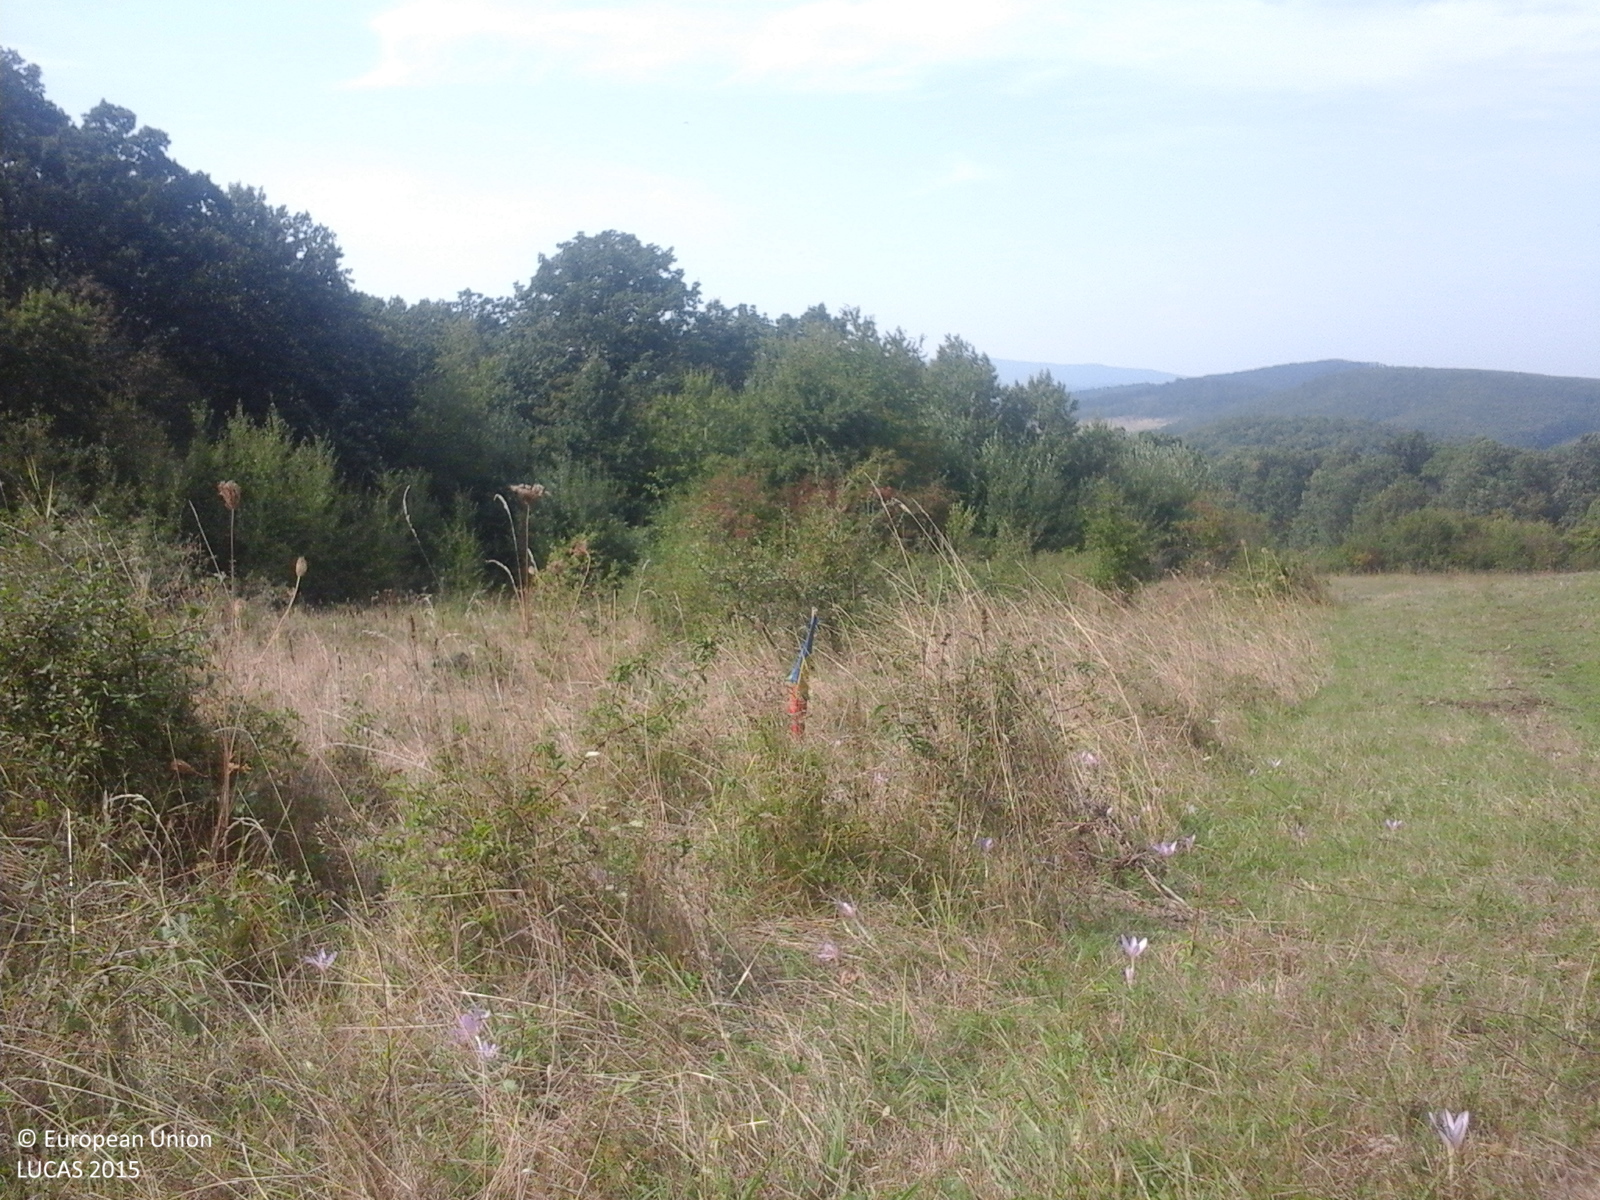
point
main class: Grassland
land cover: Spontaneously vegetated surfaces
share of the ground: > 75 %
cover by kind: herbaceous plants 100 %
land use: Fallow land
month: September
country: RO
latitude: 47.0907
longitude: 23.2536
